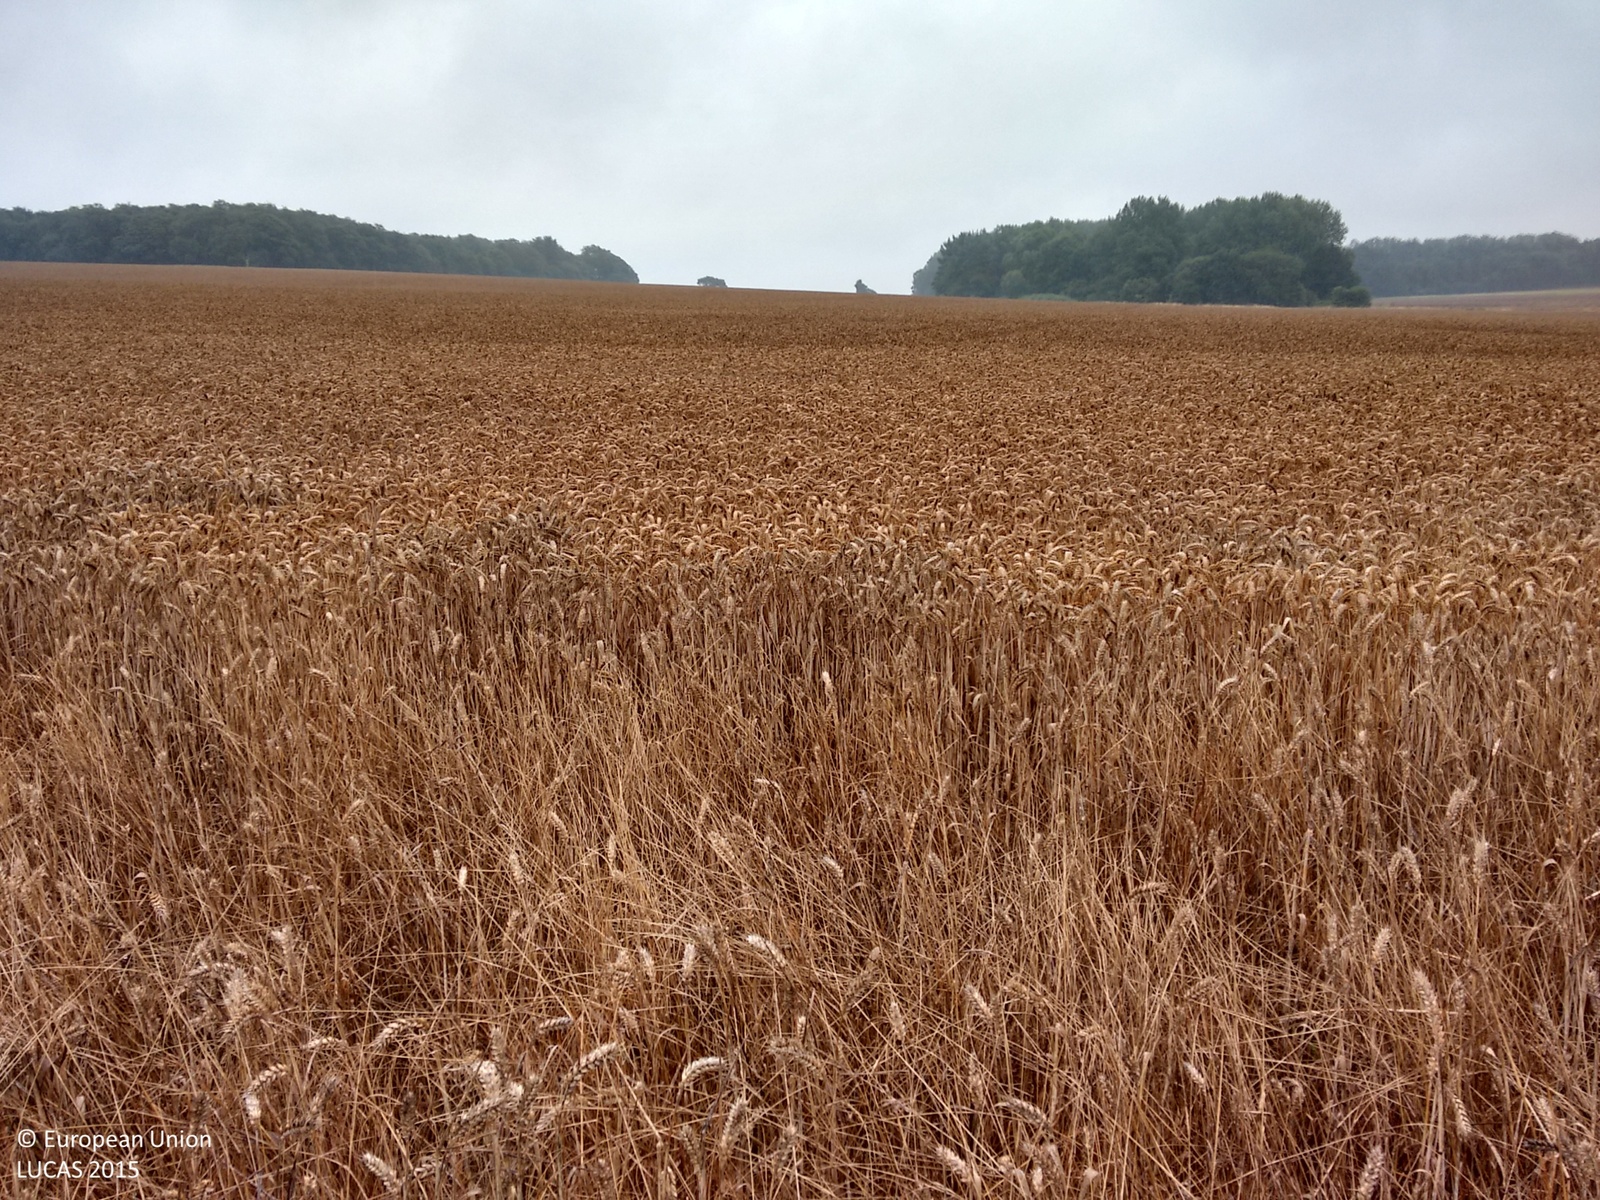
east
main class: Cropland
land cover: Common wheat
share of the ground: > 75 %
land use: Agriculture (excluding fallow land and kitchen gardens)
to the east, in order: Grass margins; Common wheat
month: August
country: GB
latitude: 52.8152
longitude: 0.7911
